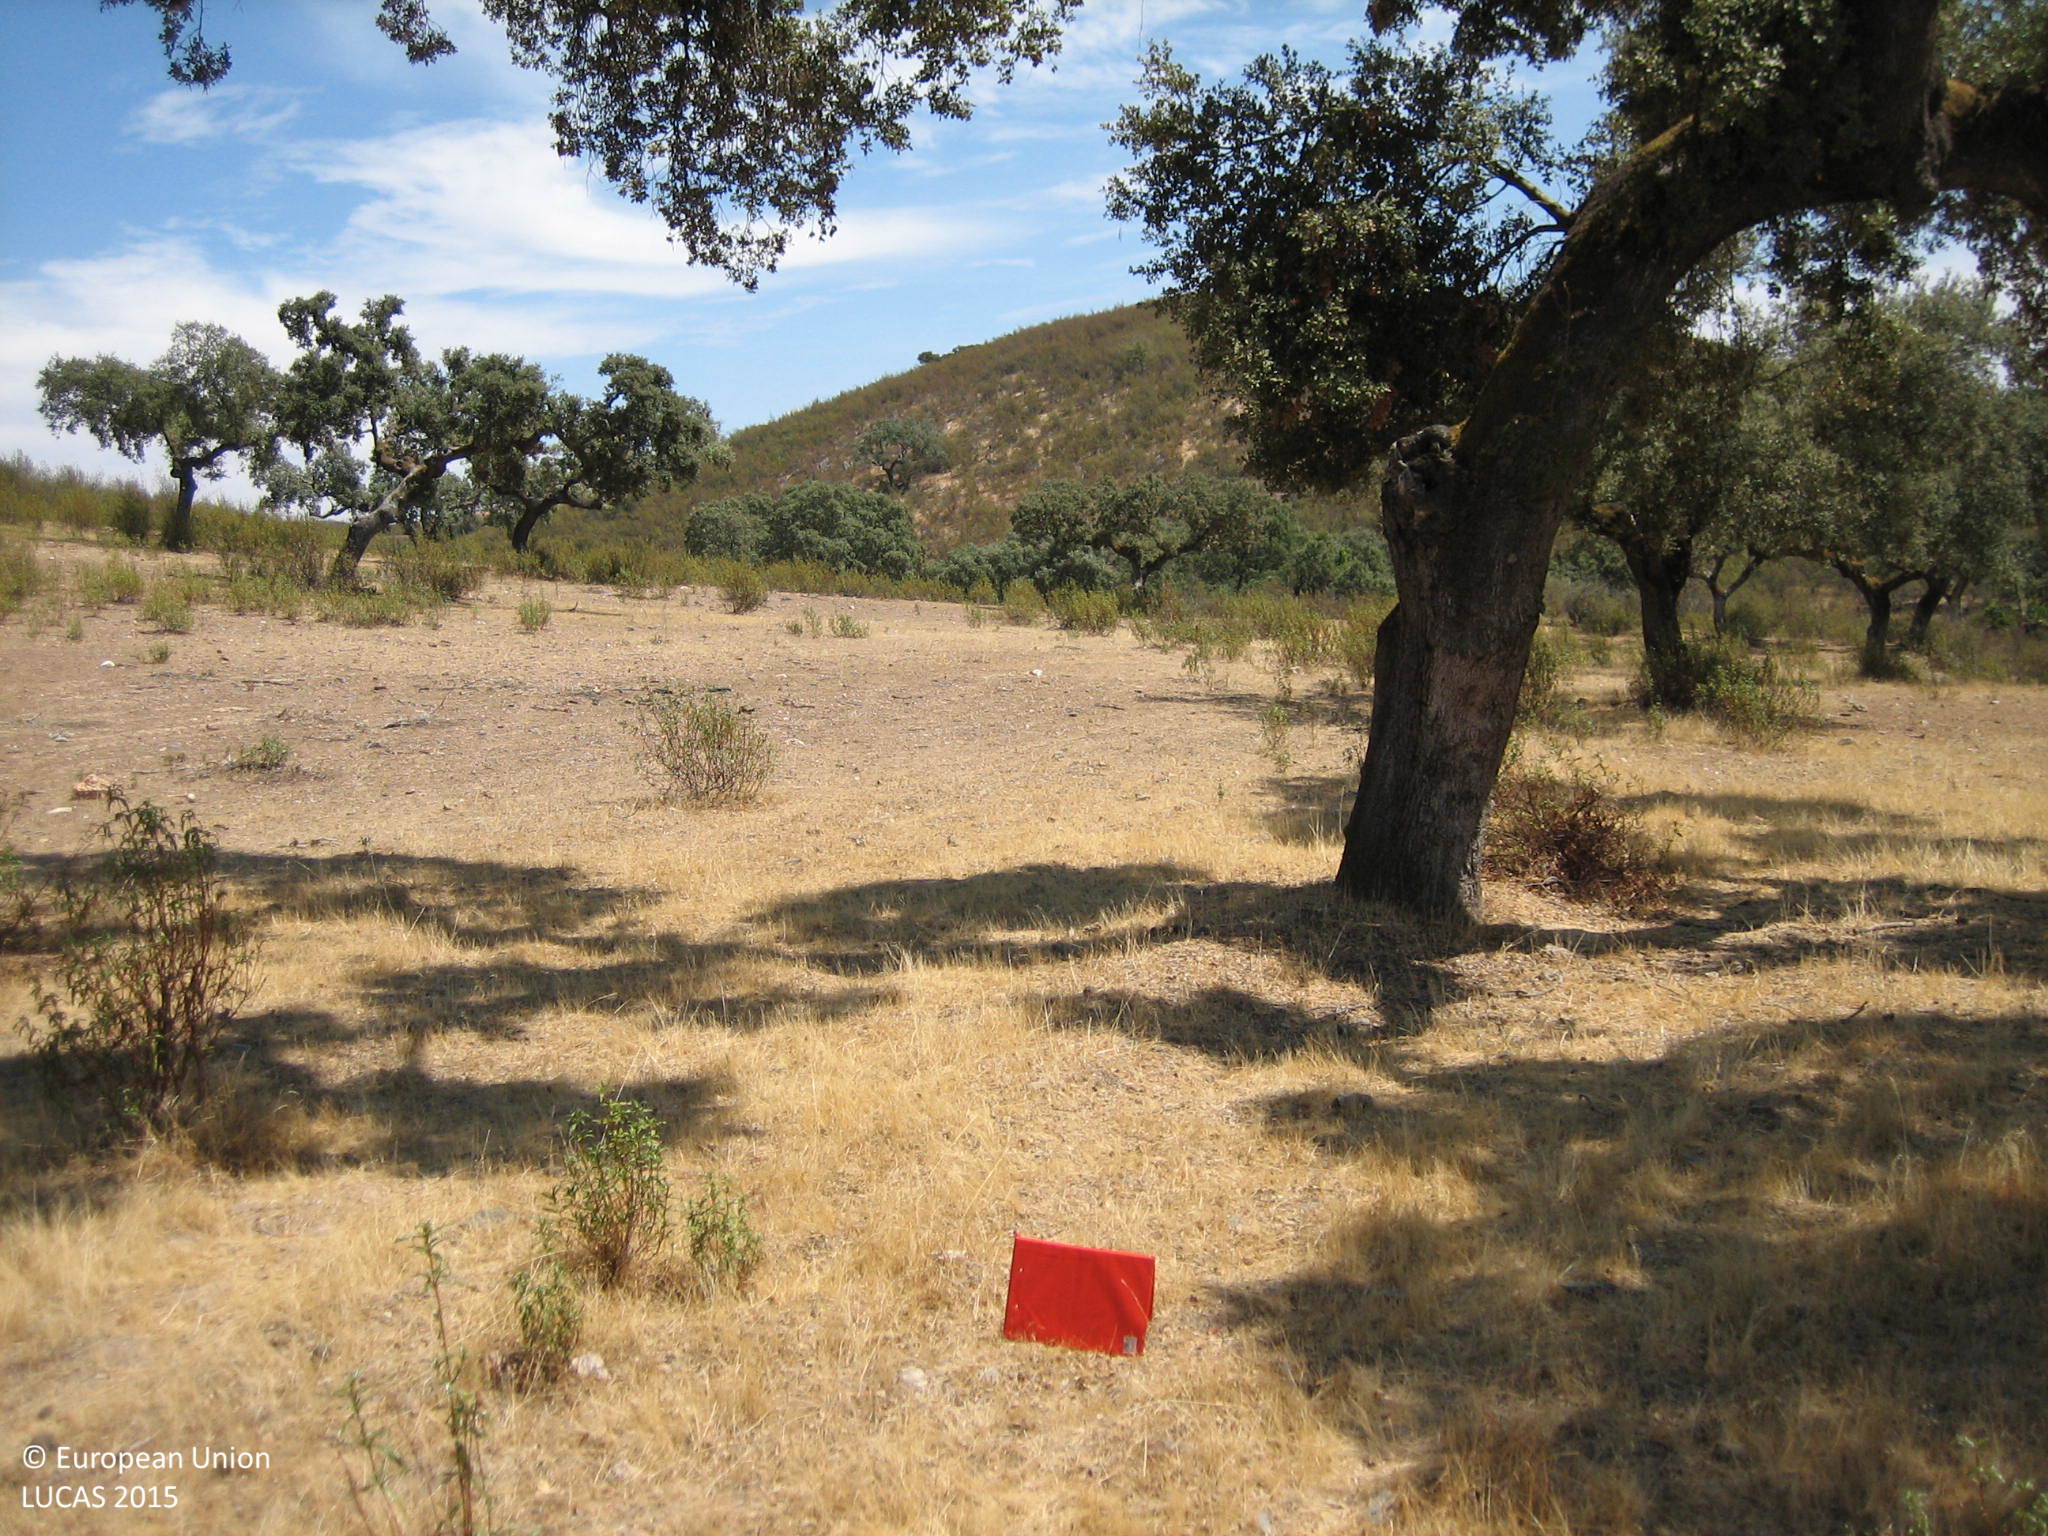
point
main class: Woodland
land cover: Broadleaved woodland
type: broadleaved evergreen forest
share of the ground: 10 - 25 %
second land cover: Grassland without tree/shrub cover
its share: 50 - 75 %
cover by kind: herbaceous plants 50 %, unconsolidated bare surface 25 %, broadleaved forest trees 20 %, shrubs 5 %
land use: Forestry
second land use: Agriculture (excluding fallow land and kitchen gardens)
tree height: > 5 m
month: September
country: ES
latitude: 38.2159
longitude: -7.1129
